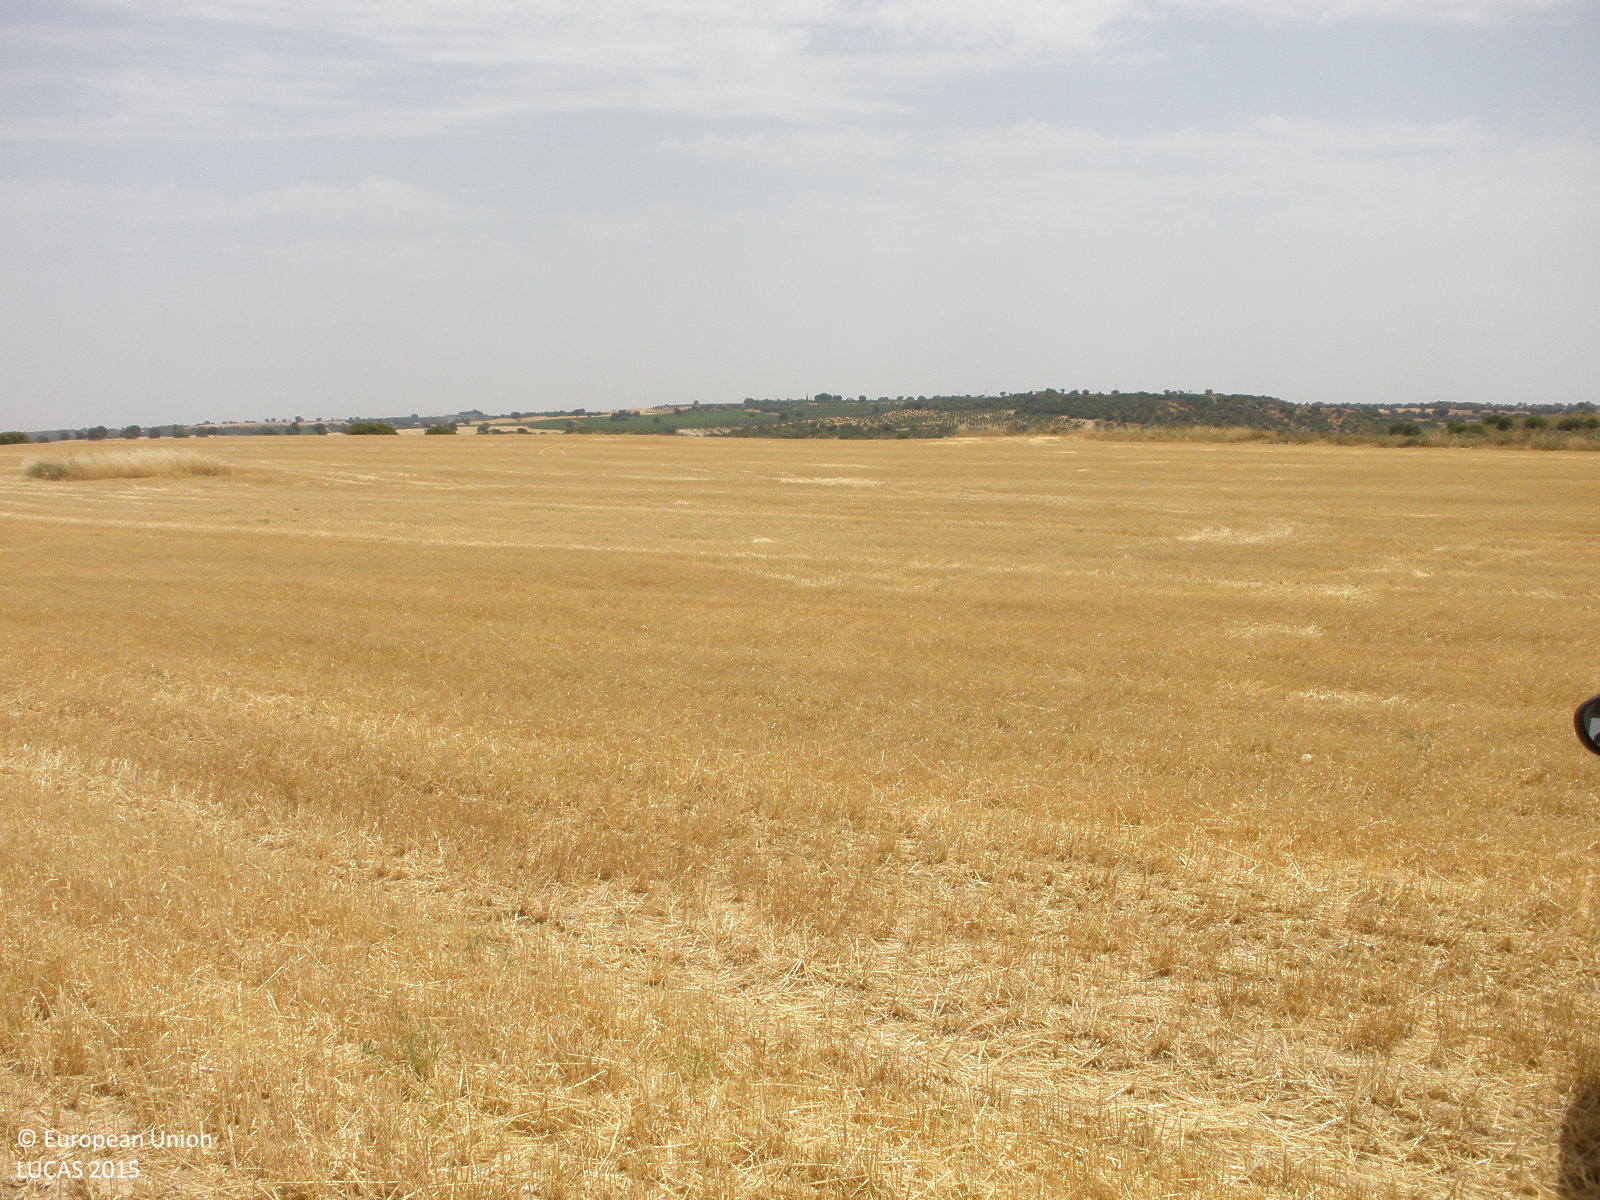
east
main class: Cropland
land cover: Barley
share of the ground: < 10 %
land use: Agriculture (excluding fallow land and kitchen gardens)
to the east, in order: Barley; Shrubland without tree cover; Barley
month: July
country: ES
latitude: 39.8403
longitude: -3.3831
